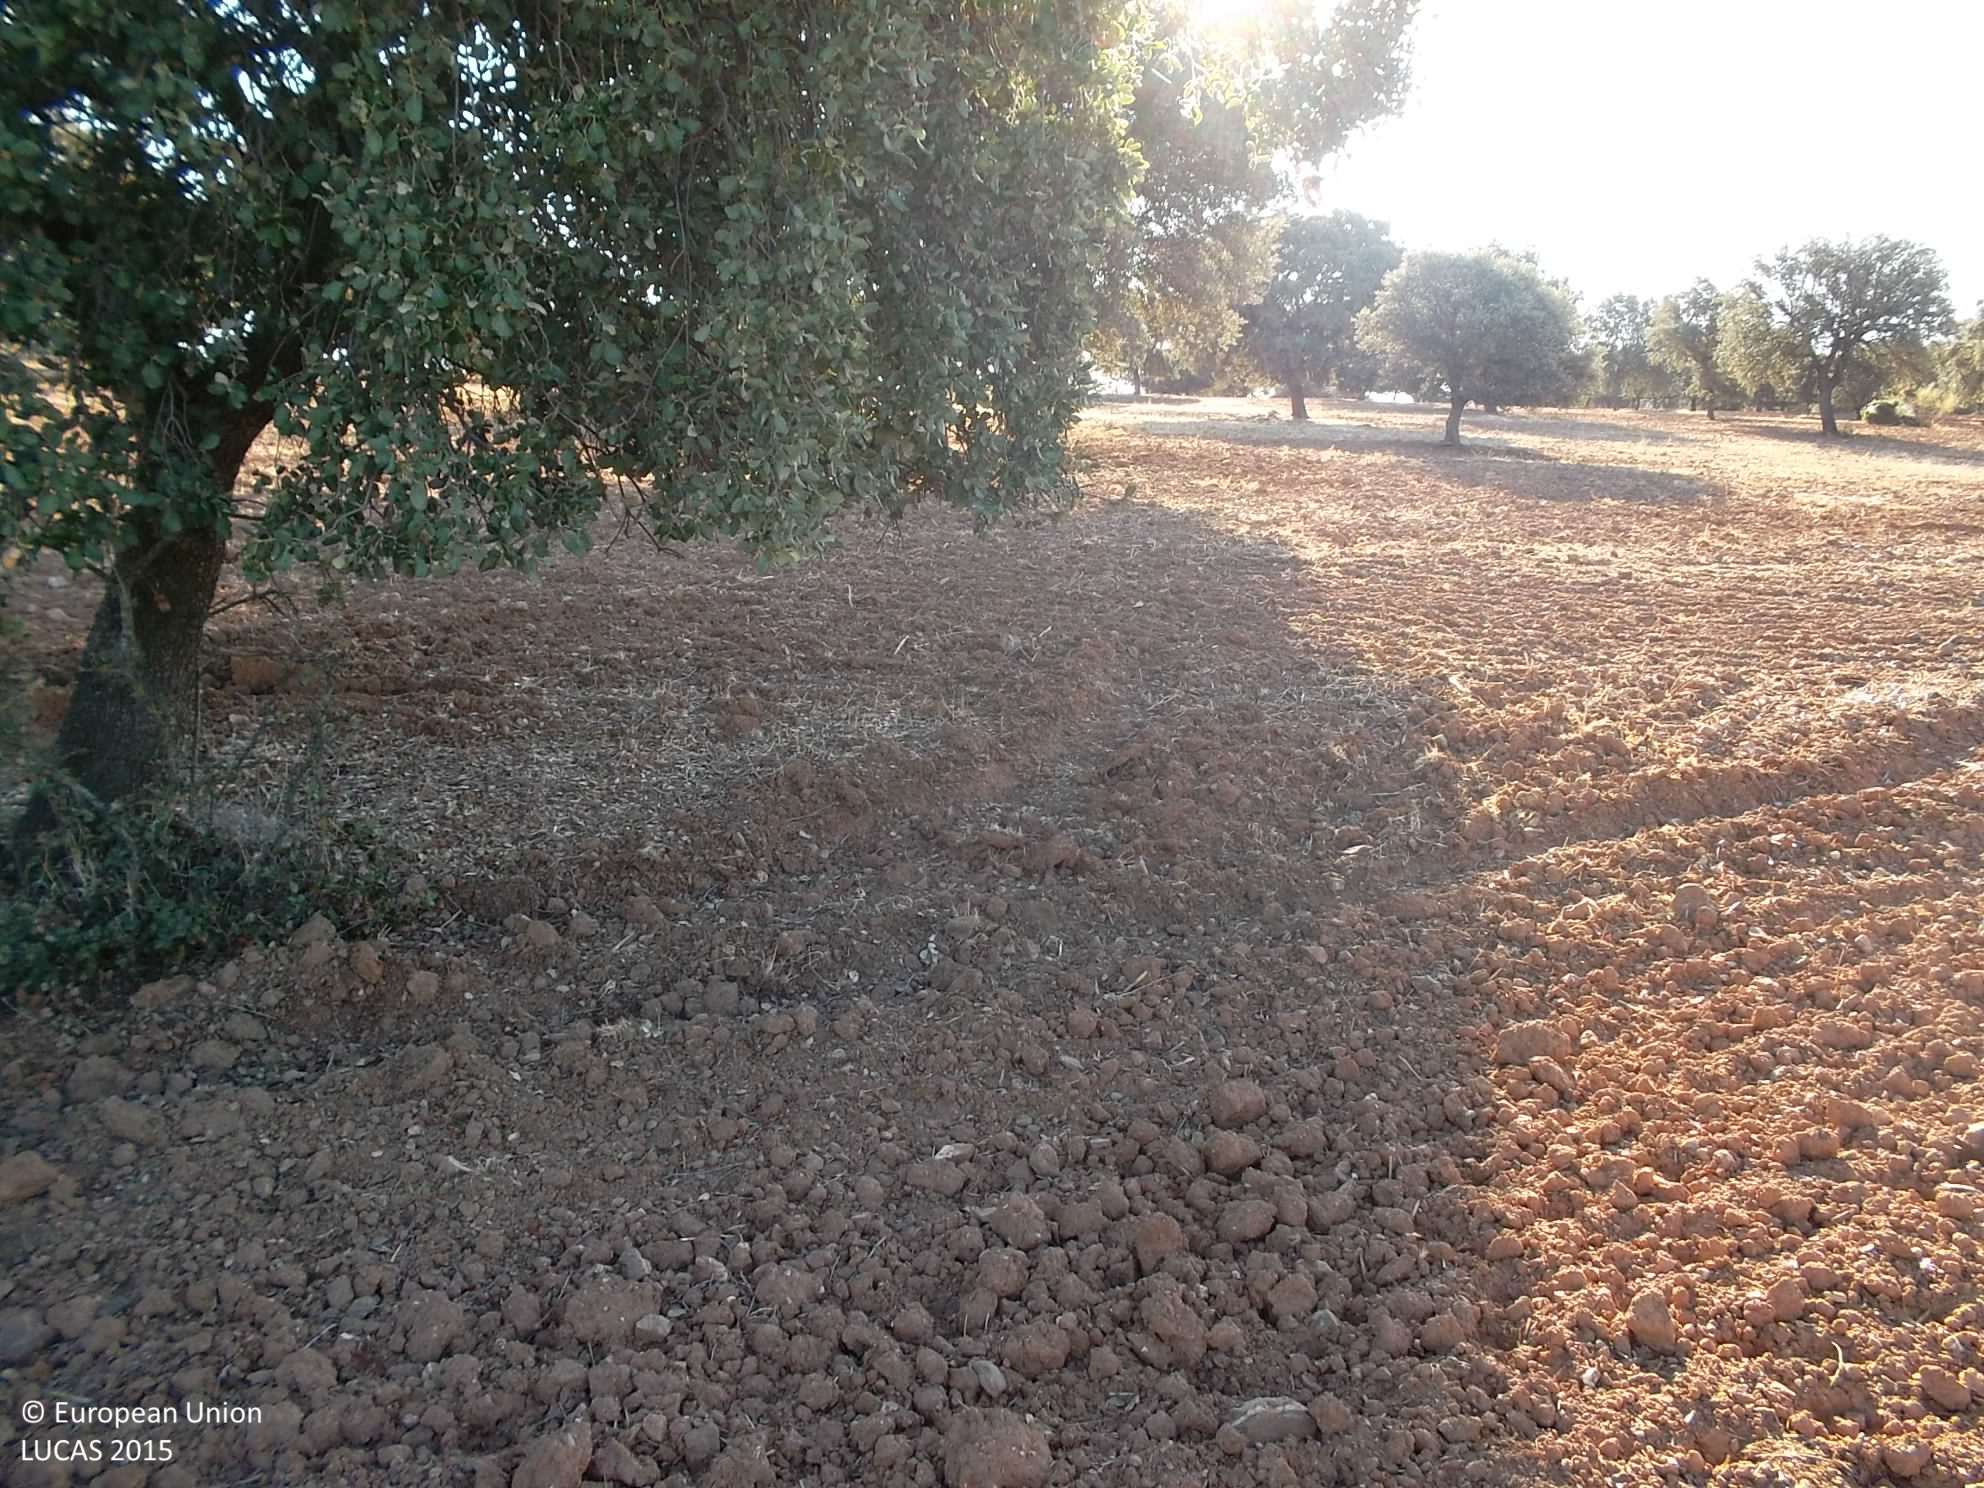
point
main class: Woodland
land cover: Broadleaved woodland
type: broadleaved evergreen forest
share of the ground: 10 - 25 %
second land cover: Spontaneously vegetated surfaces
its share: 10 - 25 %
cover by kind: unconsolidated bare surface 85 %, broadleaved forest trees 15 %
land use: Forestry
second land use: Fallow land
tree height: > 5 m
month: July
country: ES
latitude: 38.5058
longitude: -5.7616
